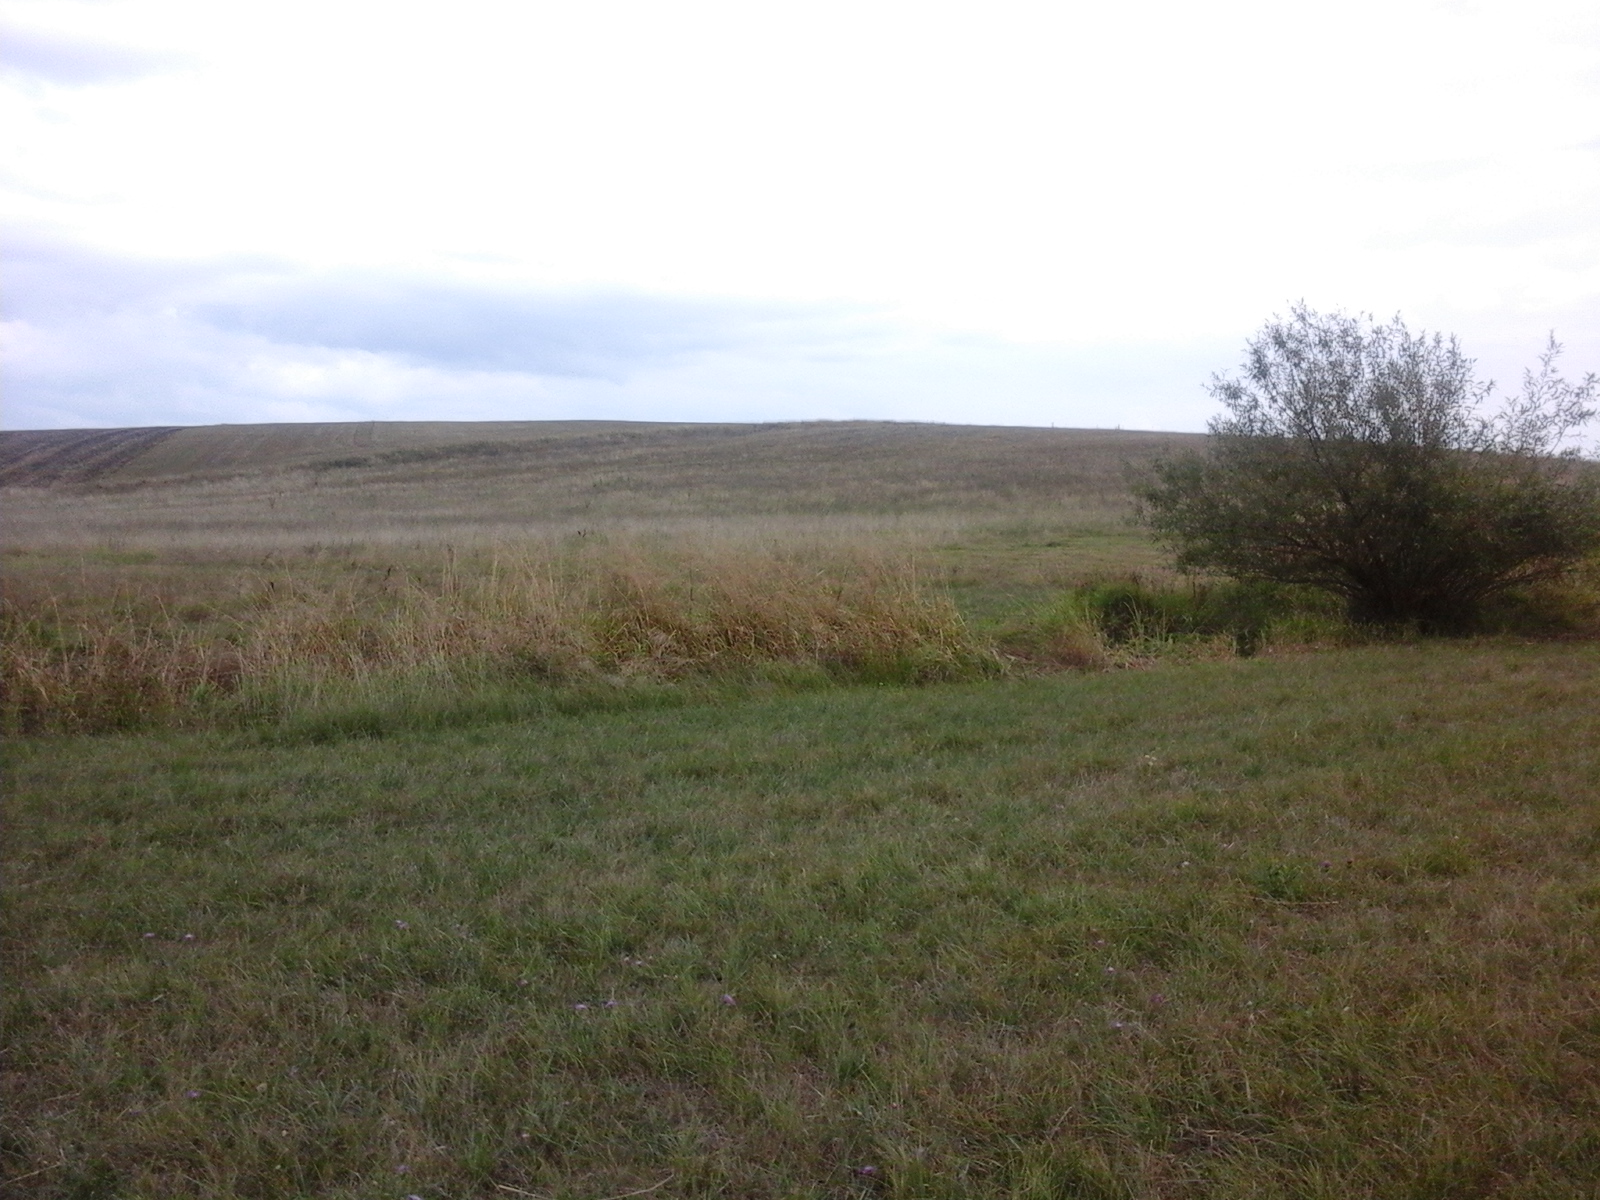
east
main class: Grassland
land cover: Grassland without tree/shrub cover
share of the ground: > 75 %
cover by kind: herbaceous plants 100 %
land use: Agriculture (excluding fallow land and kitchen gardens)
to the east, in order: Grassland without tree/shrub cover; Single bushes/trees; Ditches and canals; Grassland without tree/shrub cover; Common wheat
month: August
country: RO
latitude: 45.5172
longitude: 21.4378
